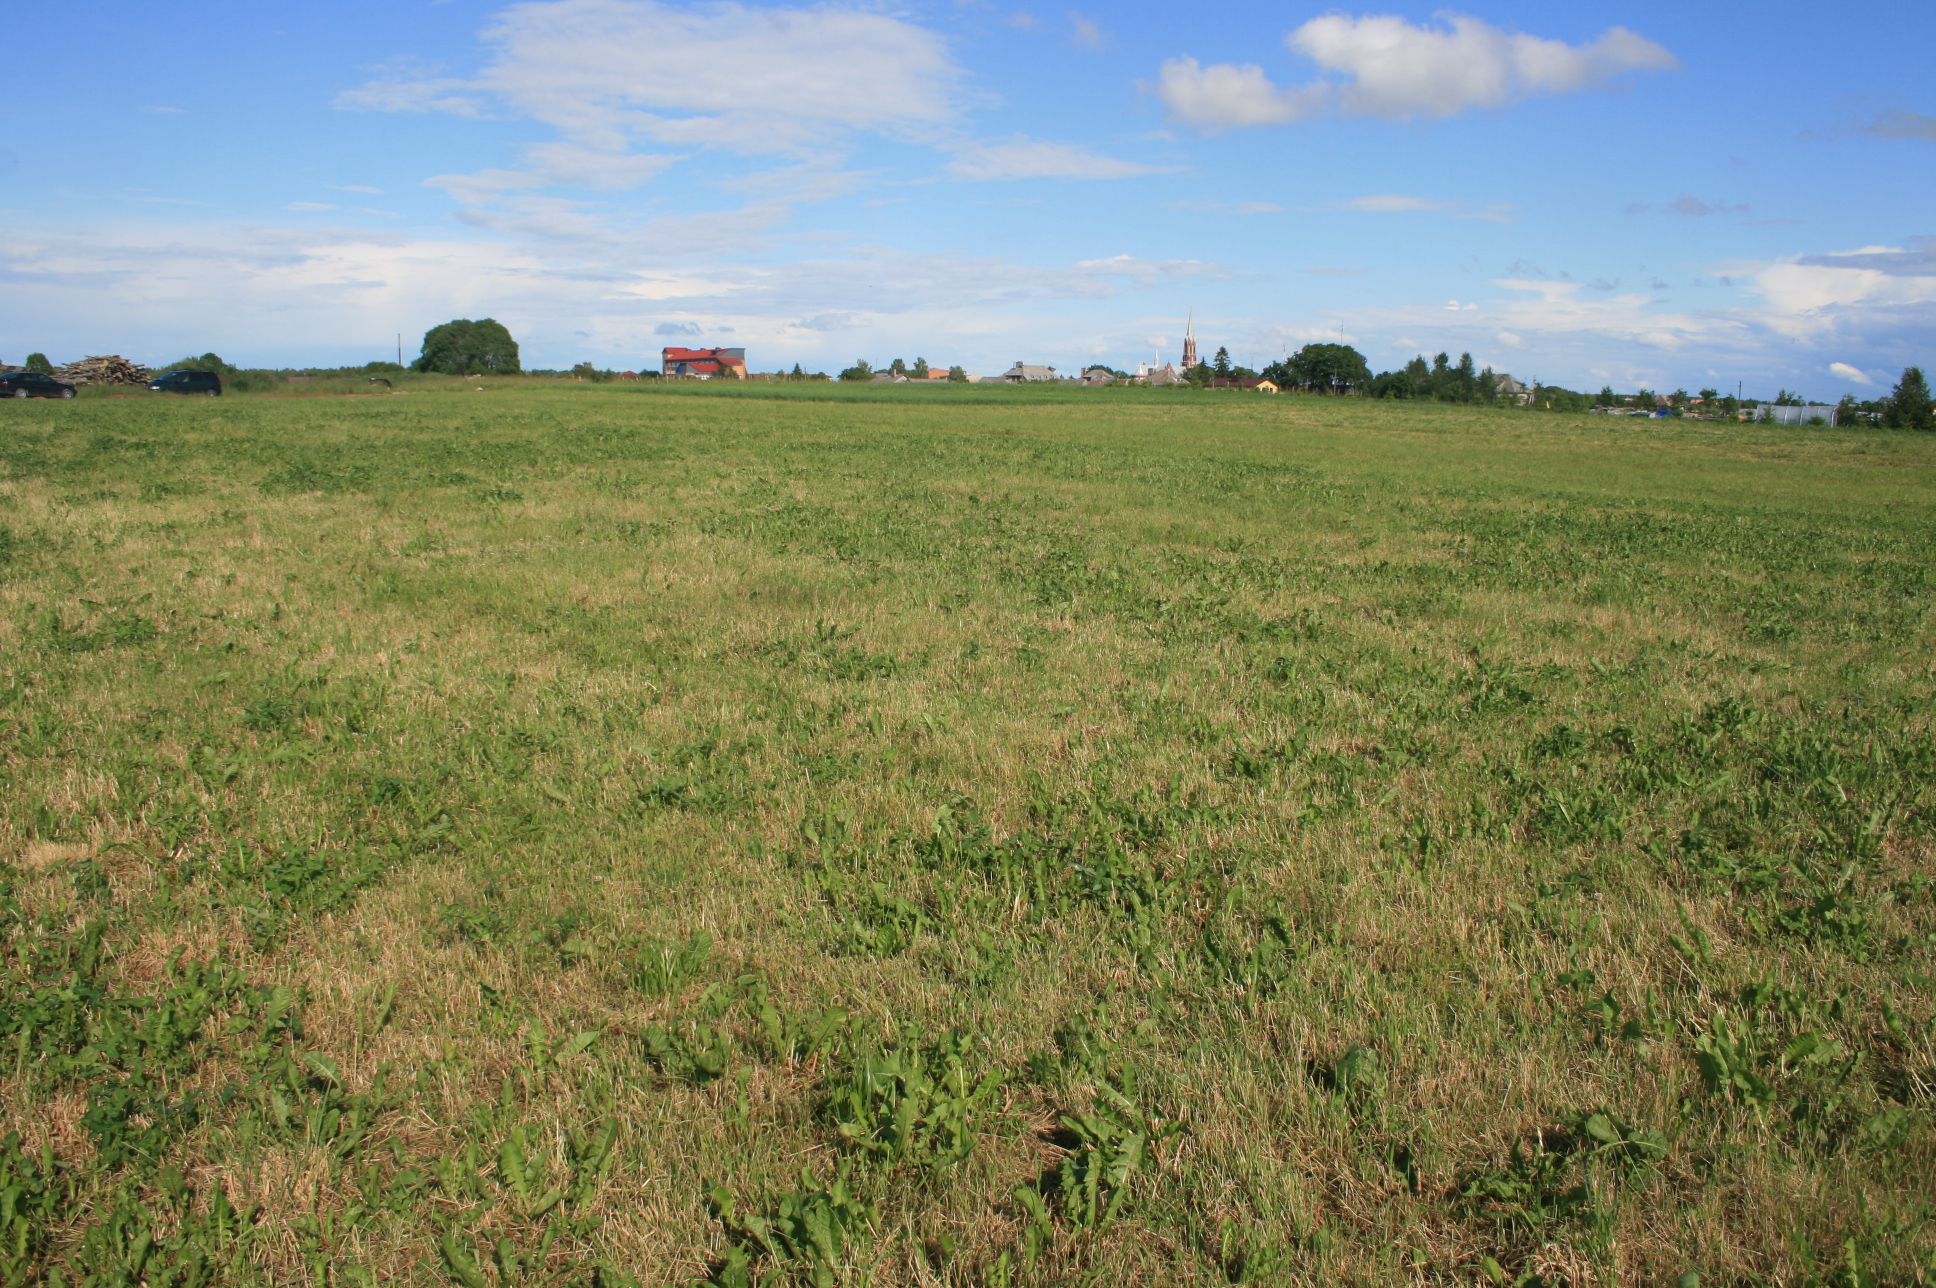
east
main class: Grassland
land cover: Grassland without tree/shrub cover
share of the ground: > 75 %
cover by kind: herbaceous plants 100 %
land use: Agriculture (excluding fallow land and kitchen gardens)
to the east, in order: Grassland without tree/shrub cover; Common wheat; Grass margins; Tracks; Grassland without tree/shrub cover; Fences; Grassland without tree/shrub cover
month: June
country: LT
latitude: 55.4971
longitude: 22.1652
